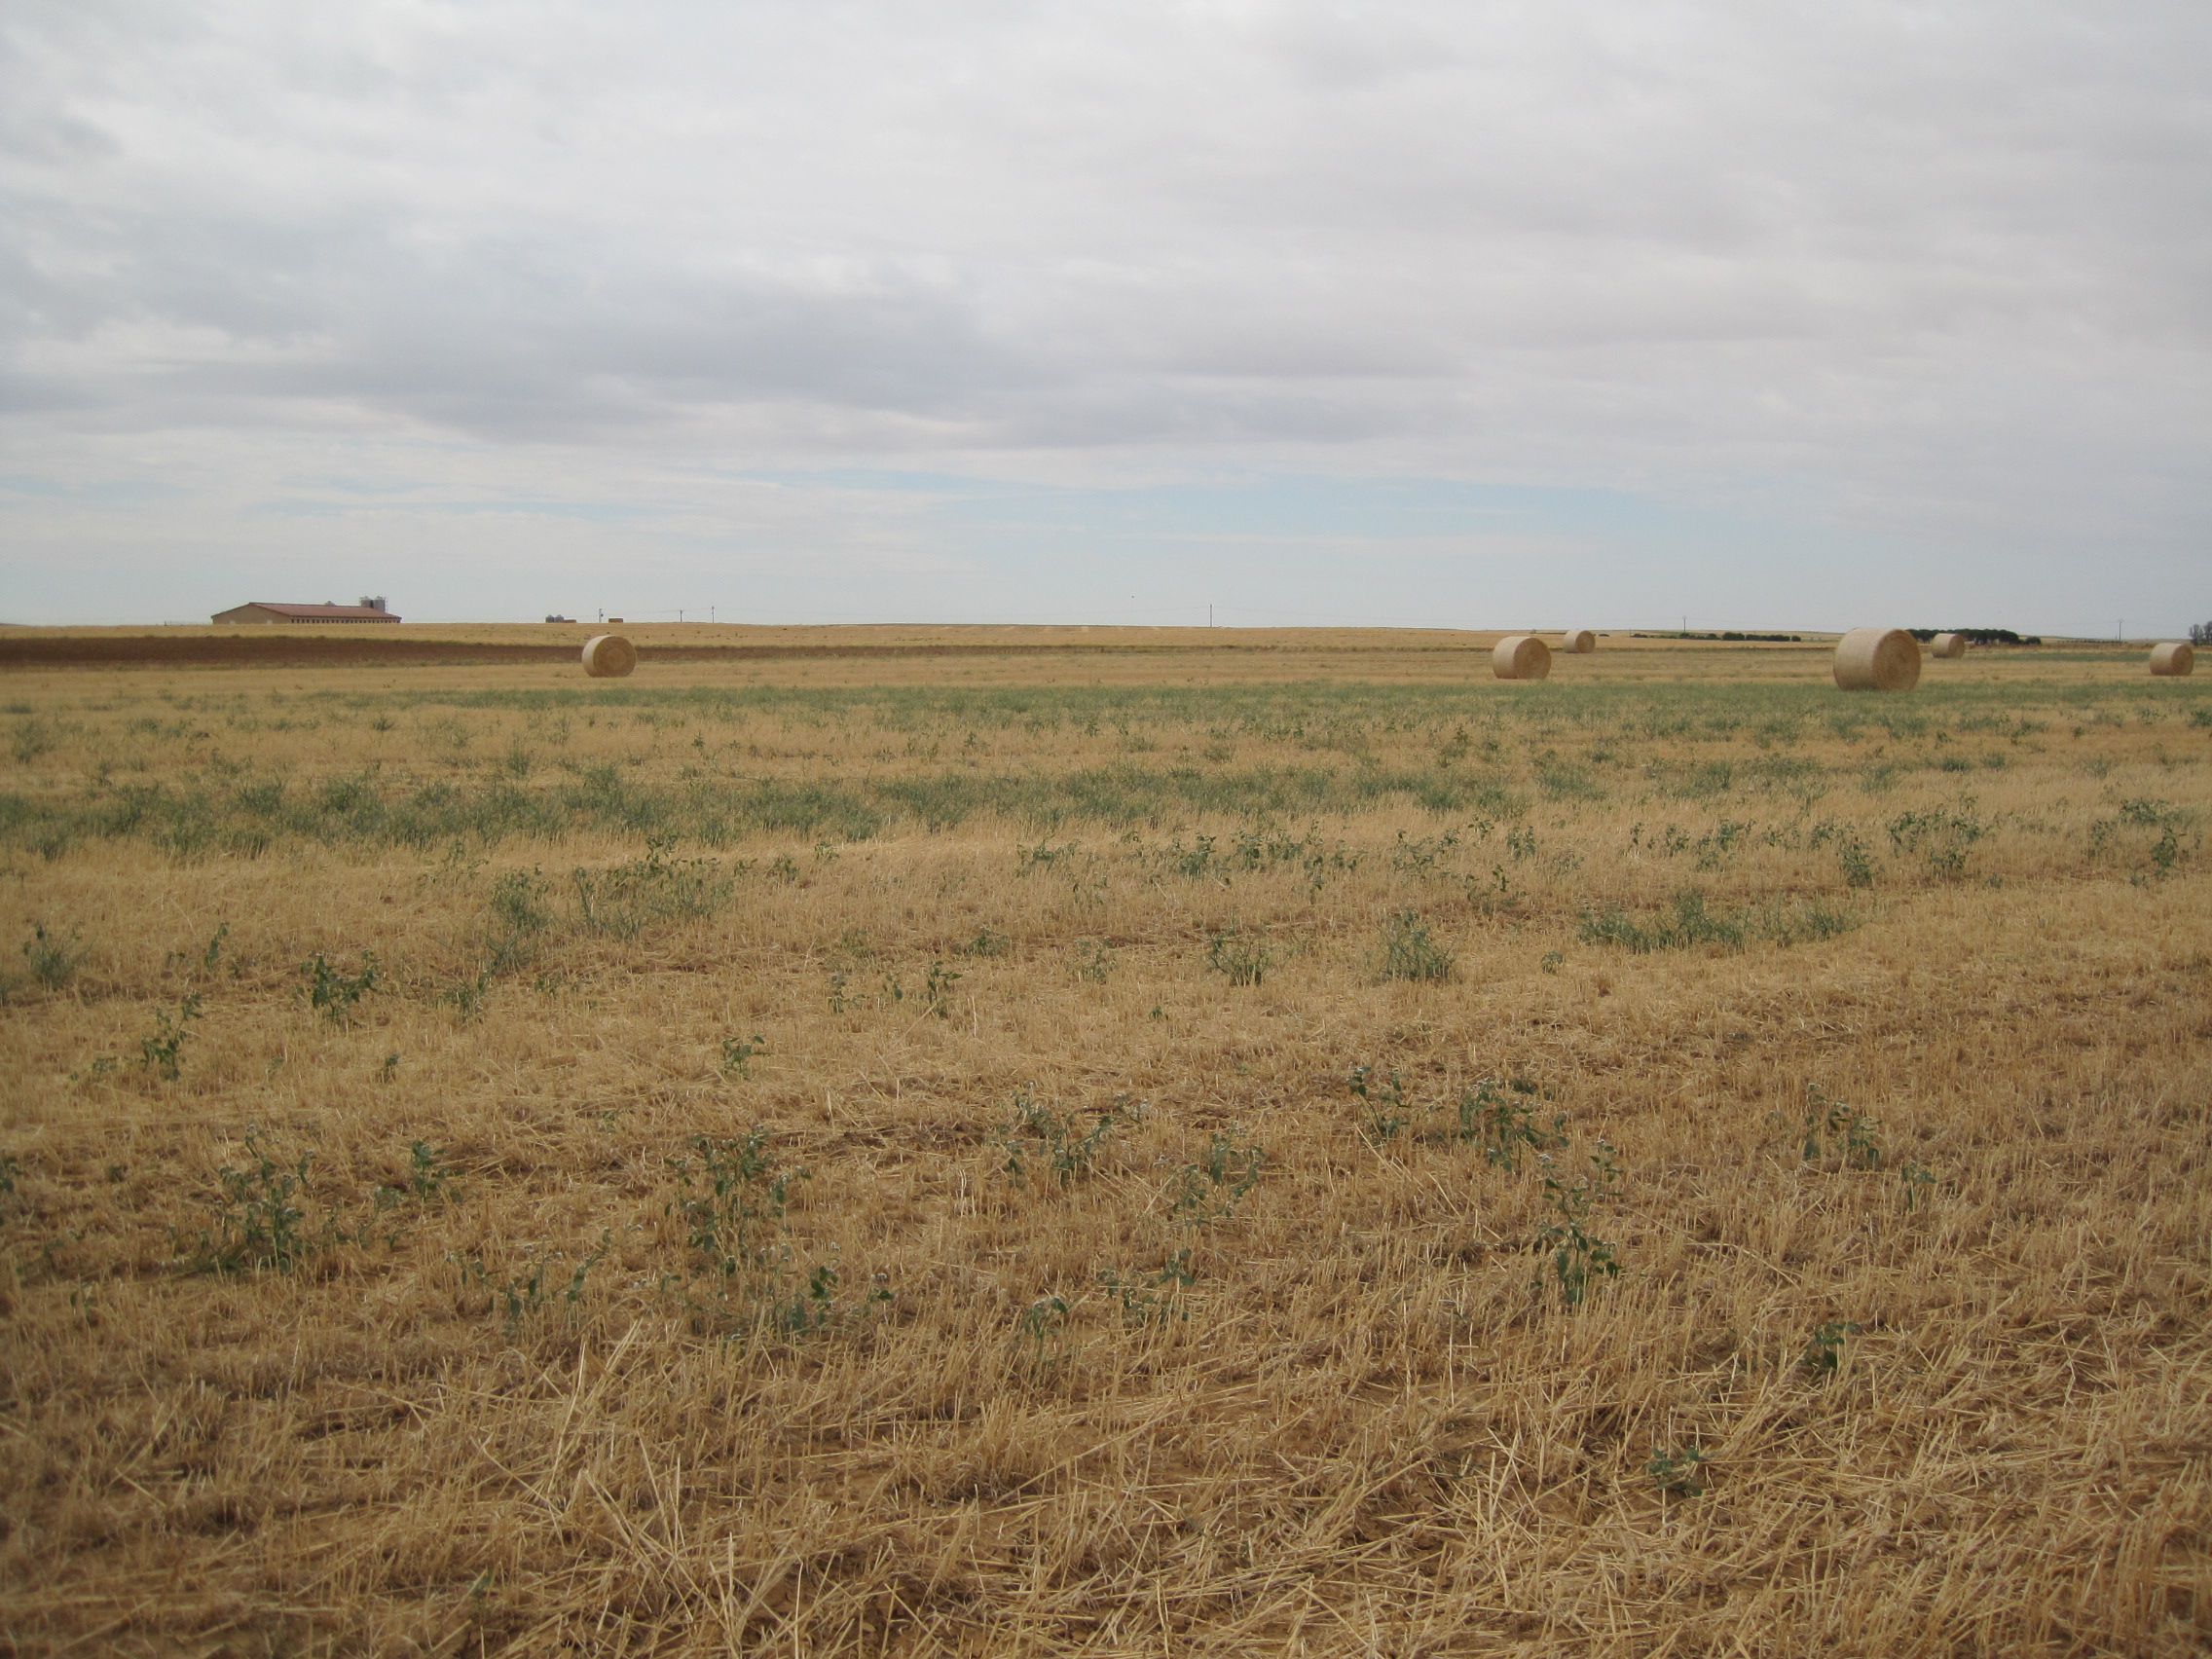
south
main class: Cropland
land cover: Barley
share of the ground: < 10 %
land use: Agriculture (excluding fallow land and kitchen gardens)
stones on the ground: < 10 %
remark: Harvested field
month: July
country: ES
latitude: 41.9956
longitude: -5.4301
